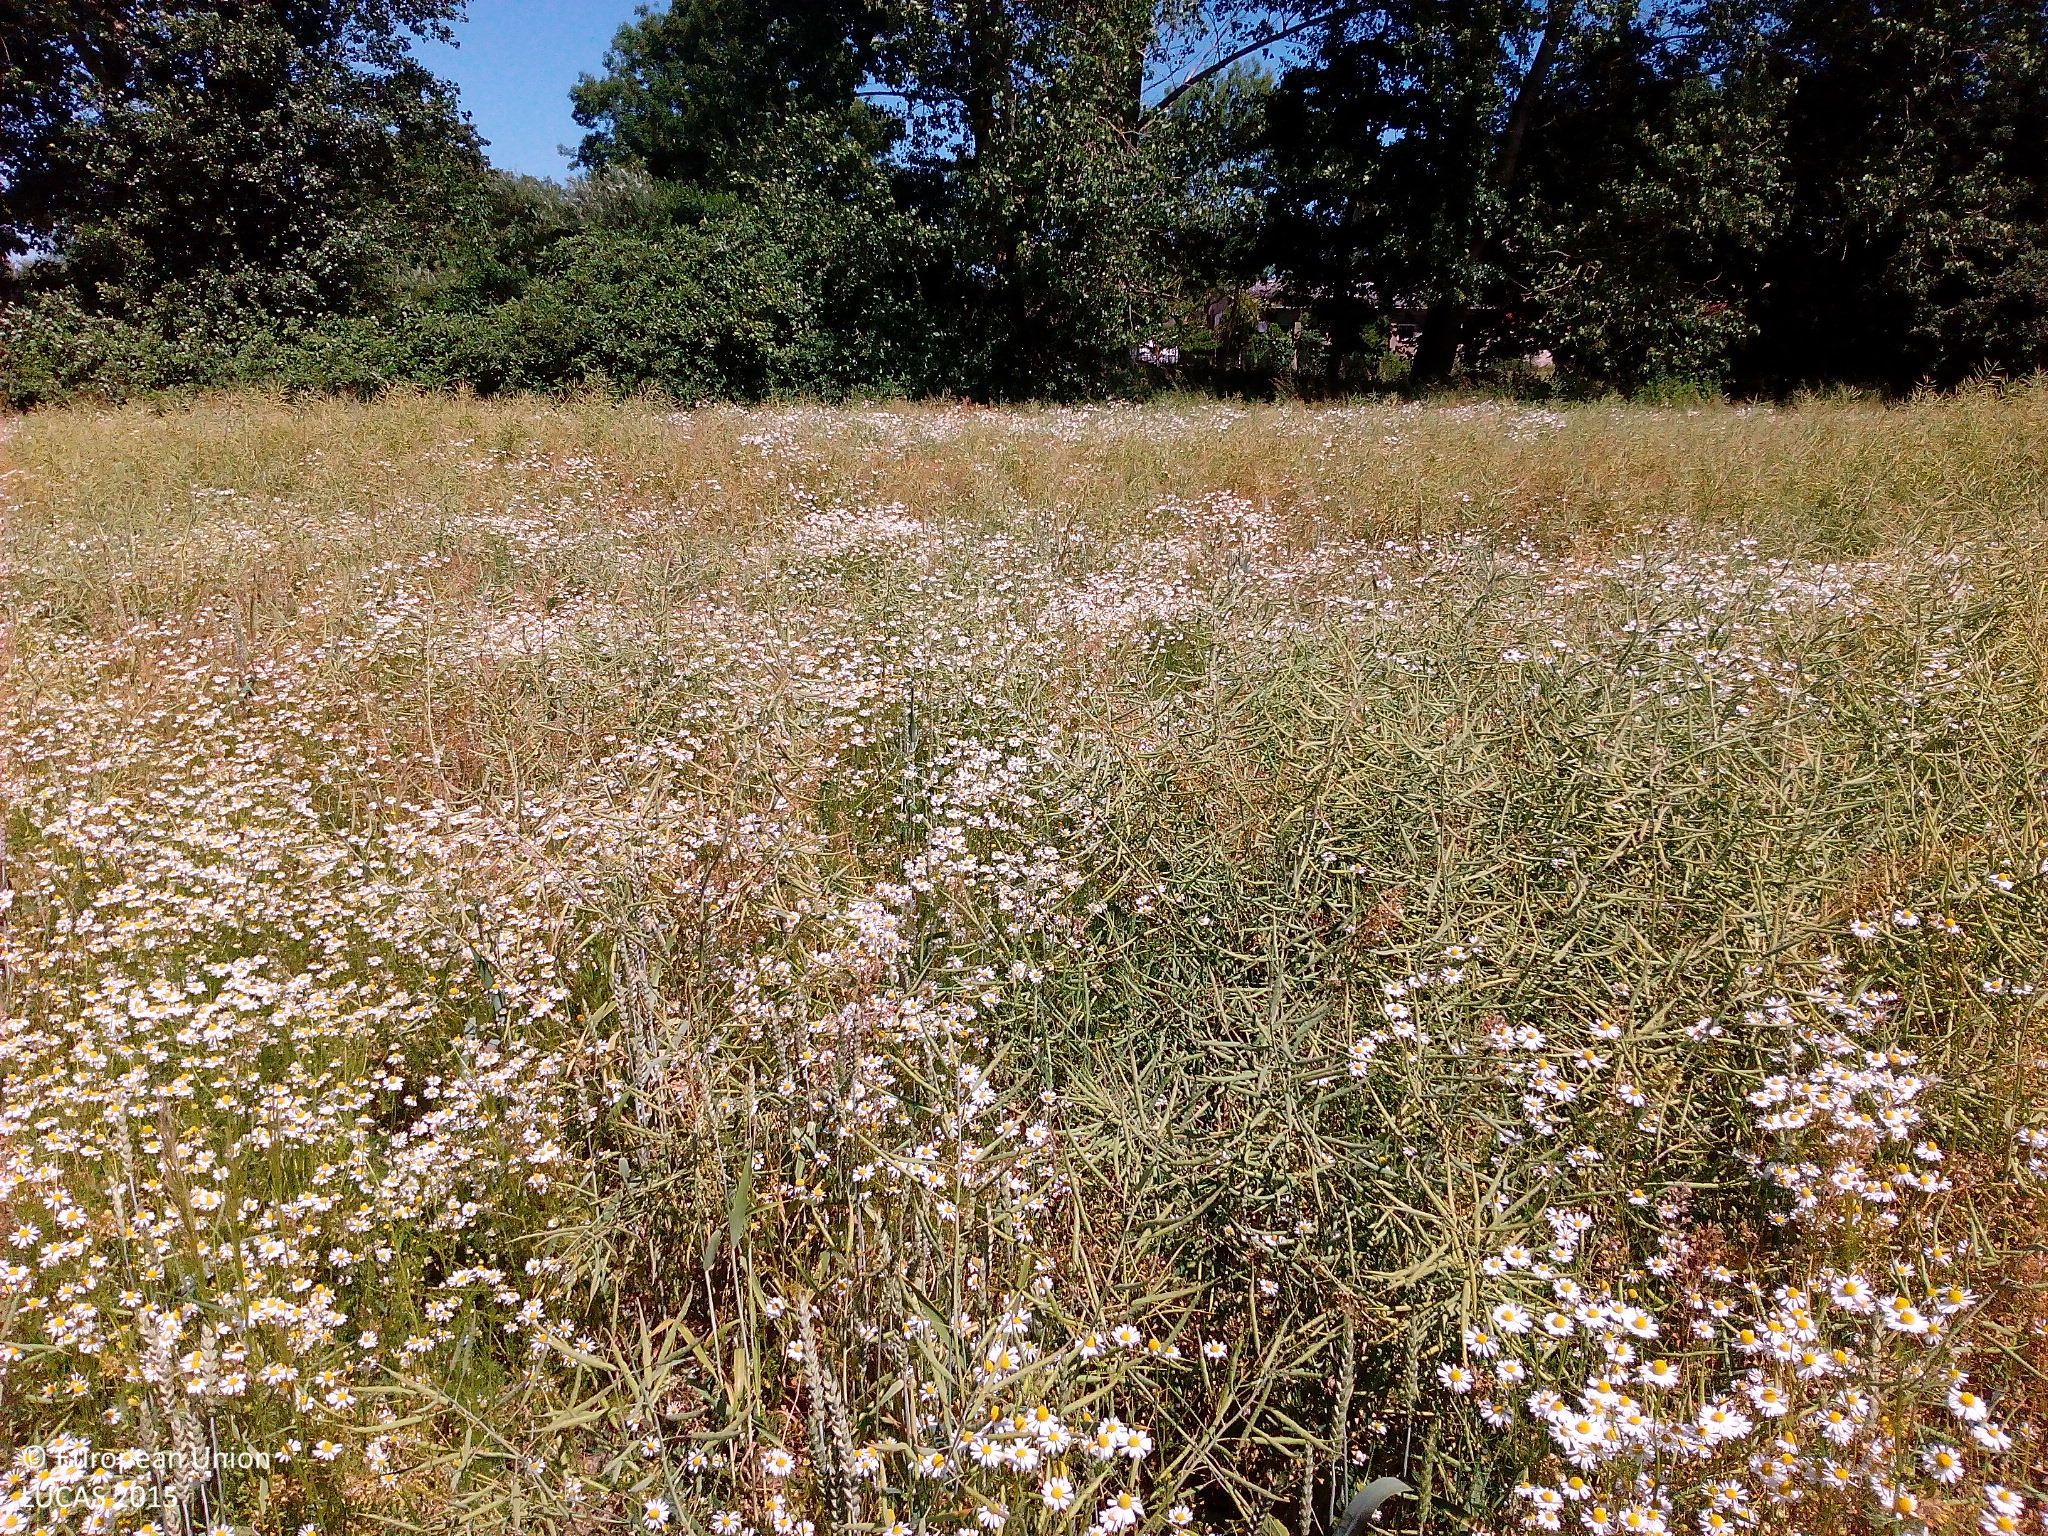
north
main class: Cropland
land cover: Rape and turnip rape
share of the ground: > 75 %
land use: Agriculture (excluding fallow land and kitchen gardens)
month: July
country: DE
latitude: 54.0410
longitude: 13.2825
